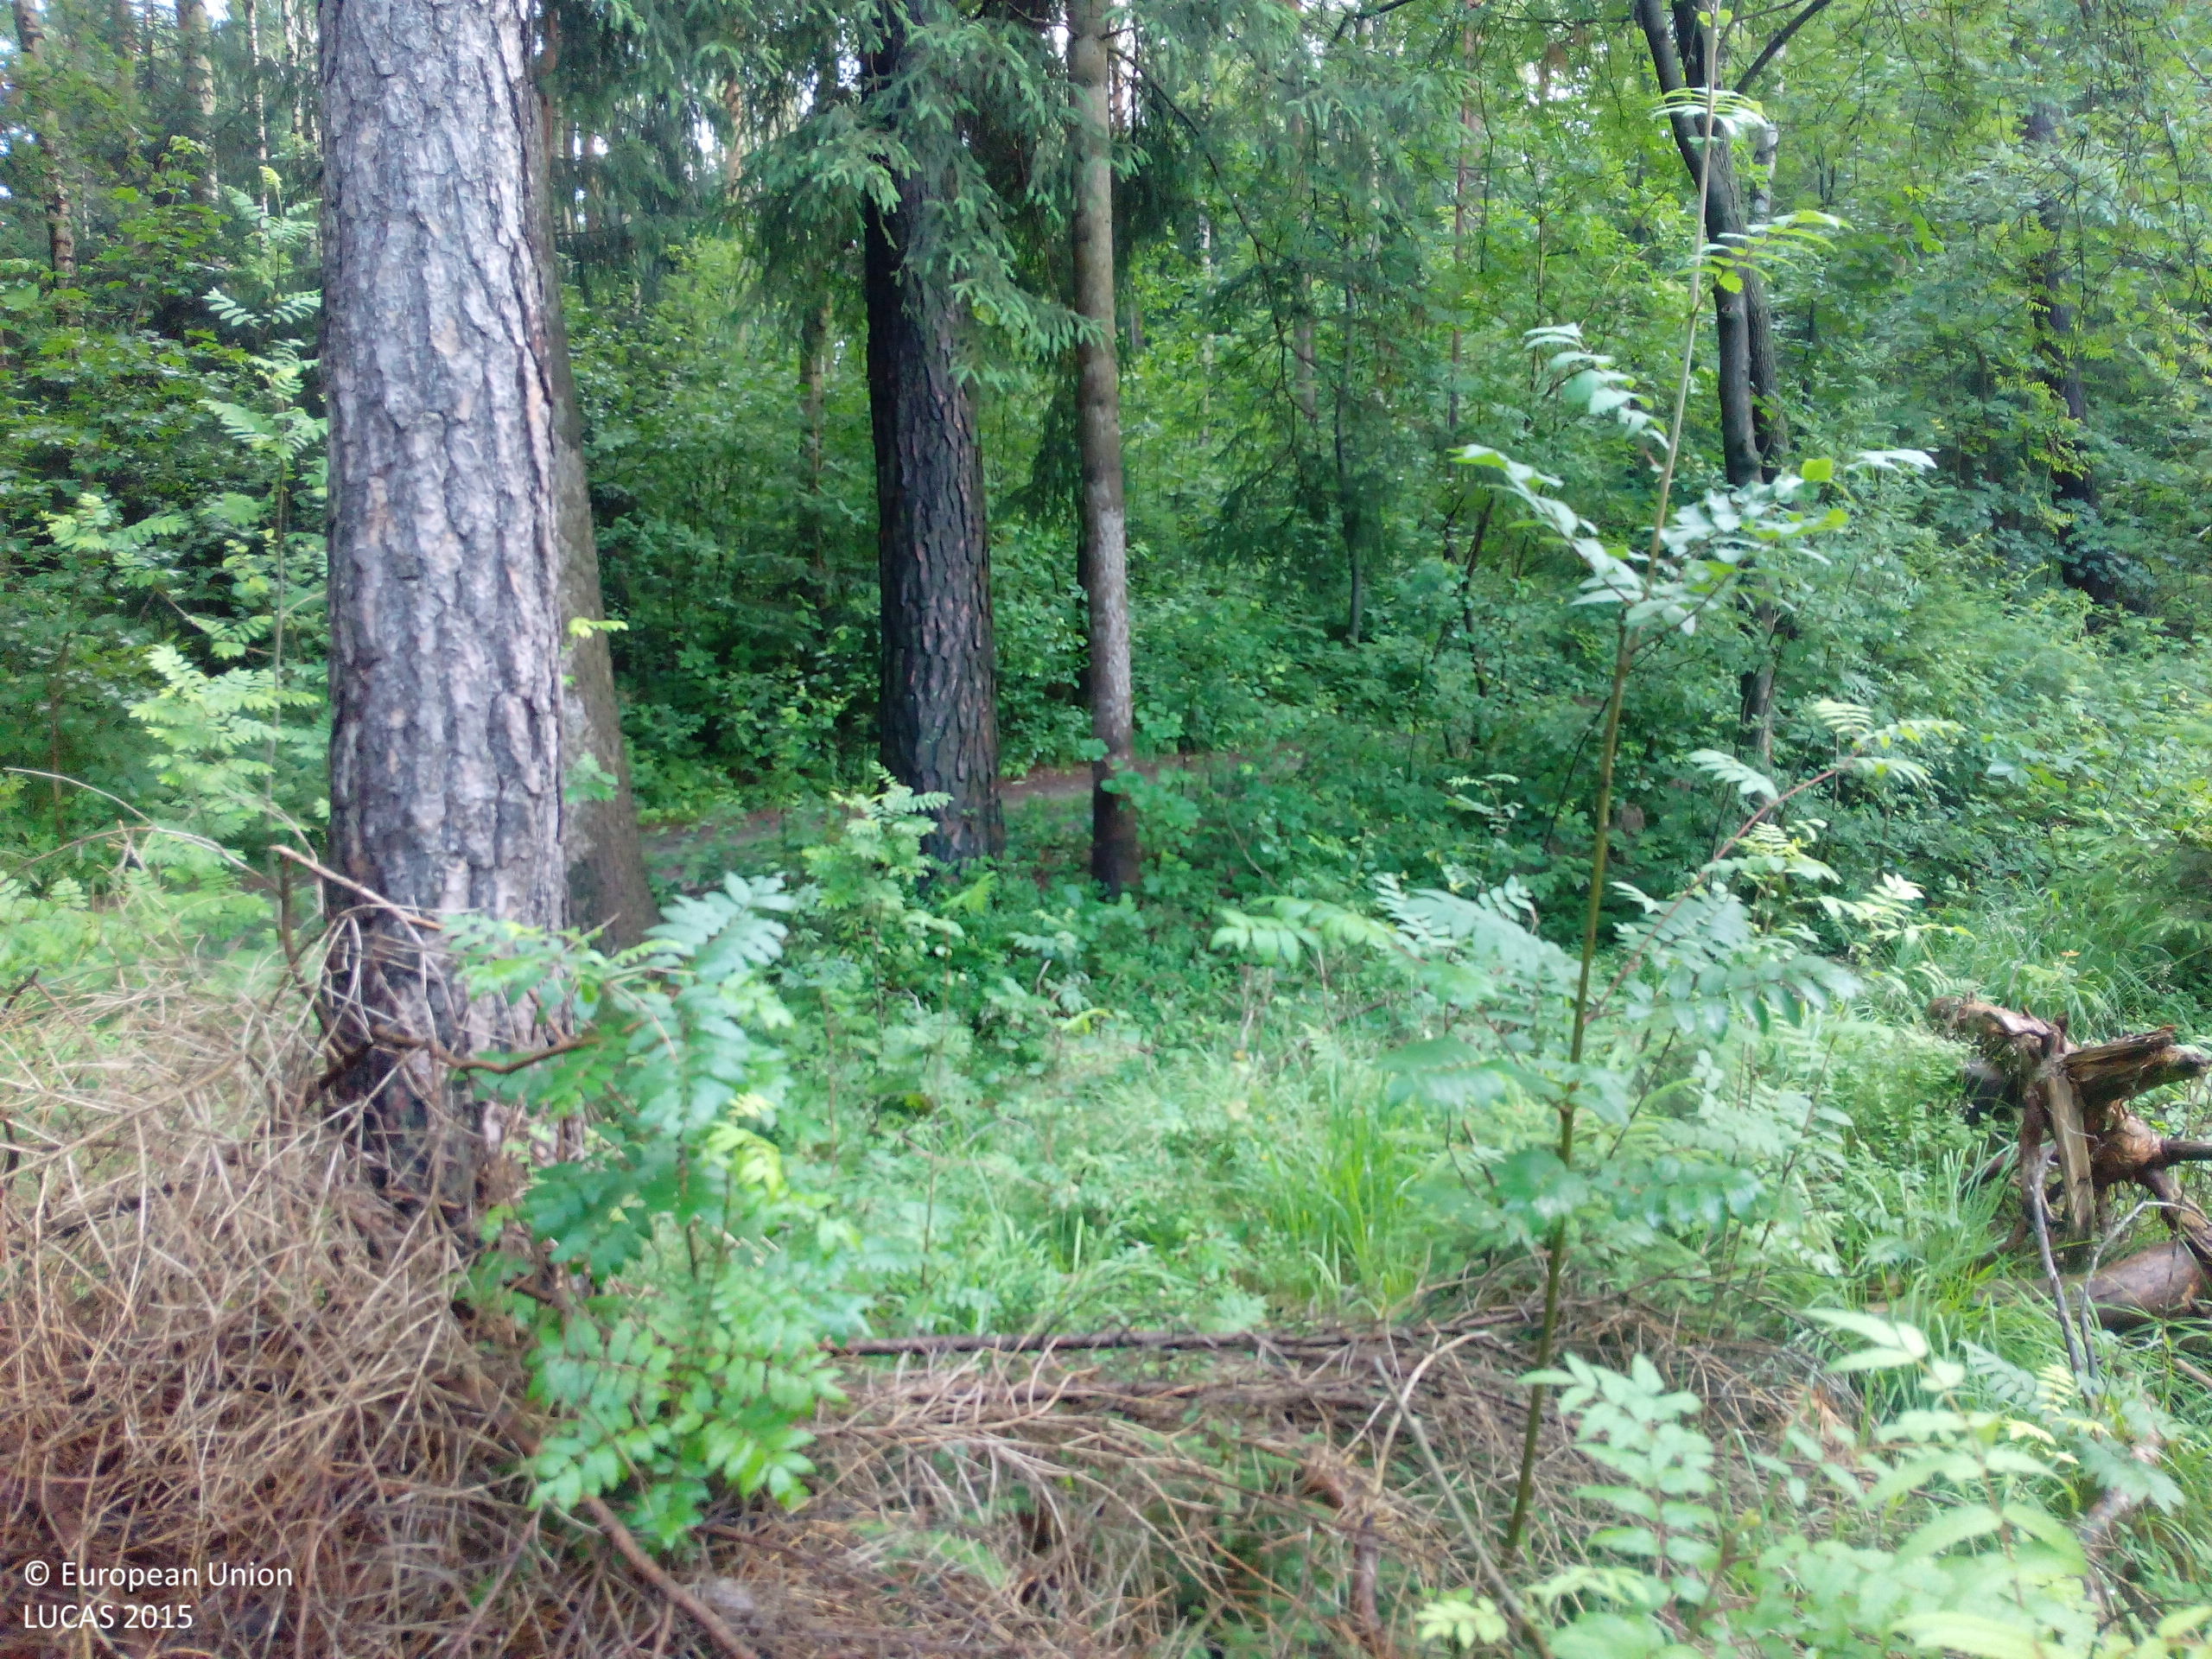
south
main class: Woodland
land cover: Spruce dominated mixed woodland
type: hemiboreal forest and nemoral coniferous forest and mixed broadleaved-coniferous forest
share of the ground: > 75 %
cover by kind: broadleaved forest trees 55 %, coniferous forest trees 25 %, shrubs 20 %
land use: Forestry
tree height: > 5 m
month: June
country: DE
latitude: 51.1945
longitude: 13.9934
